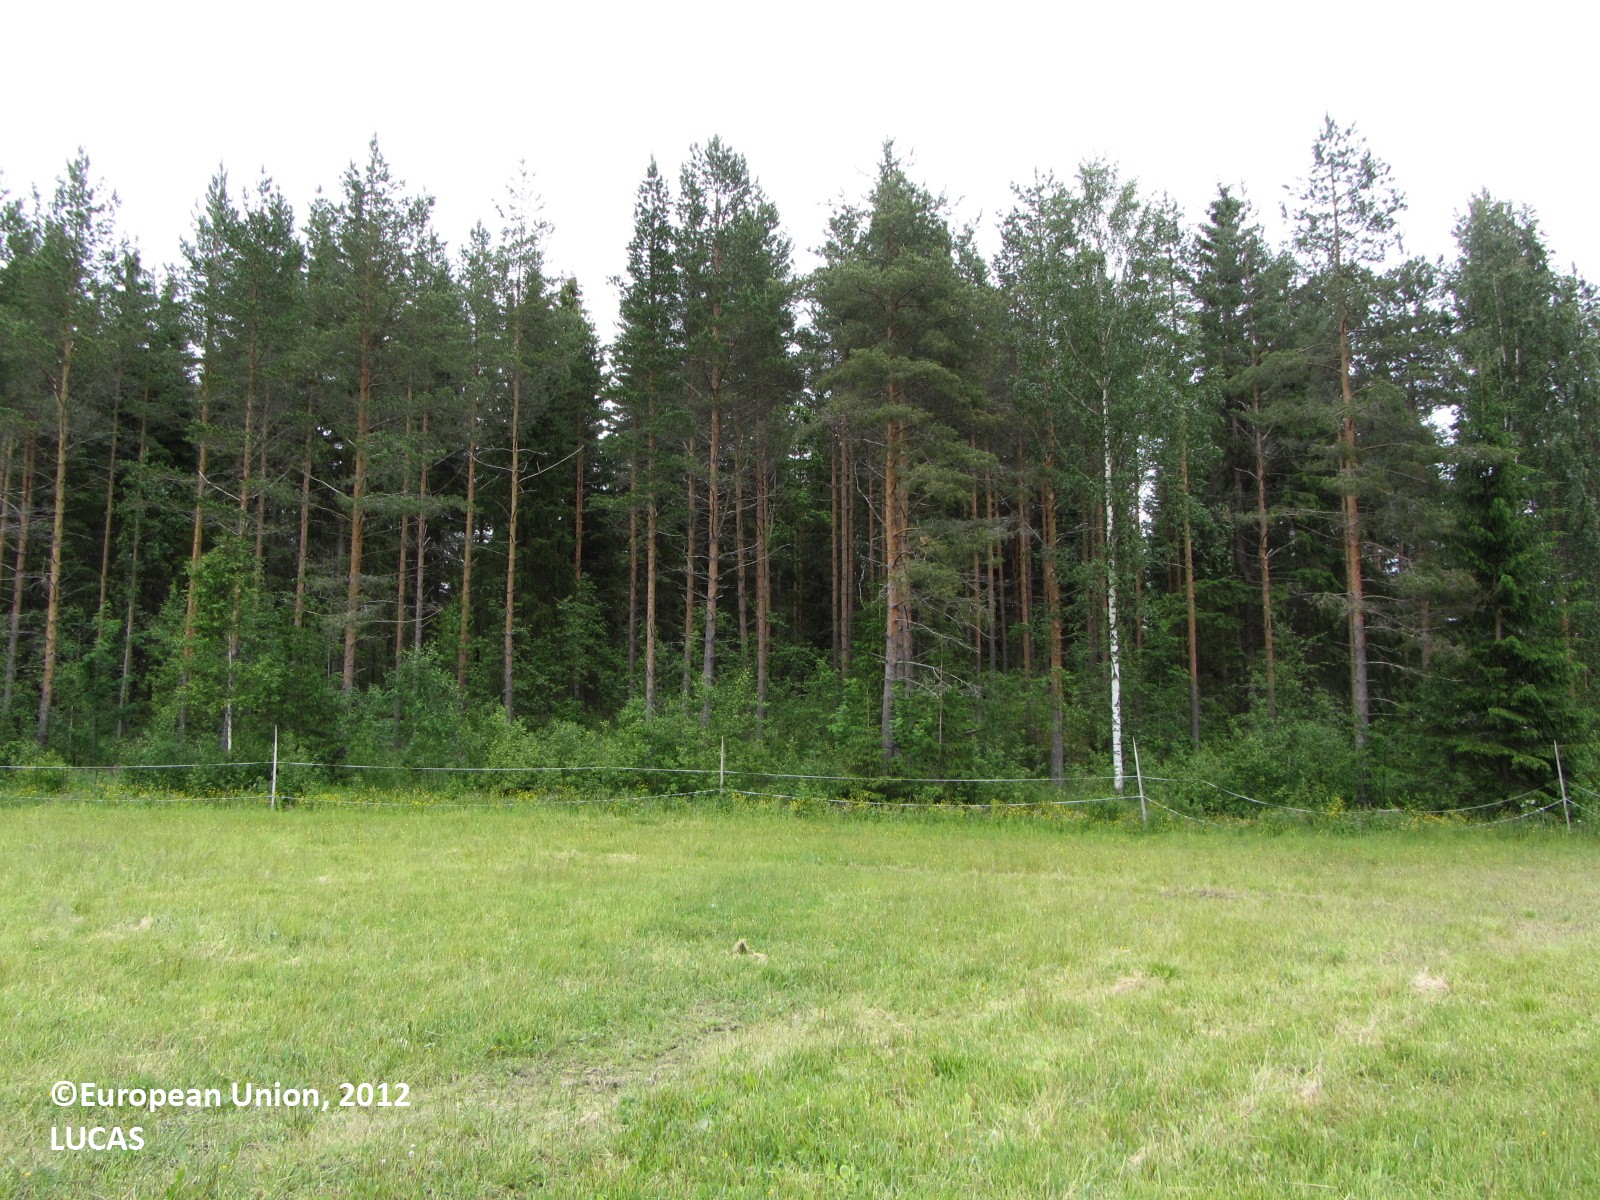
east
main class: Grassland
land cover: Grassland without tree/shrub cover
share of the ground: > 75 %
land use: Agriculture (excluding fallow land and kitchen gardens)
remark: Harvested field
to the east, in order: Grassland without tree/shrub cover; Tracks; Fences; Ditches and canals; Other mixed woodland; Spruce dominated mixed woodland; Grassland with sparse tree/shrub cover; Other mixed woodland; Spontaneously vegetated surfaces; Other mixed woodland; Grassland without tree/shrub cover; Spruce dominated mixed woodland; Grassland with sparse tree/shrub cover; Grassland without tree/shrub cover
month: June
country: FI
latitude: 62.6565
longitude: 25.2678
